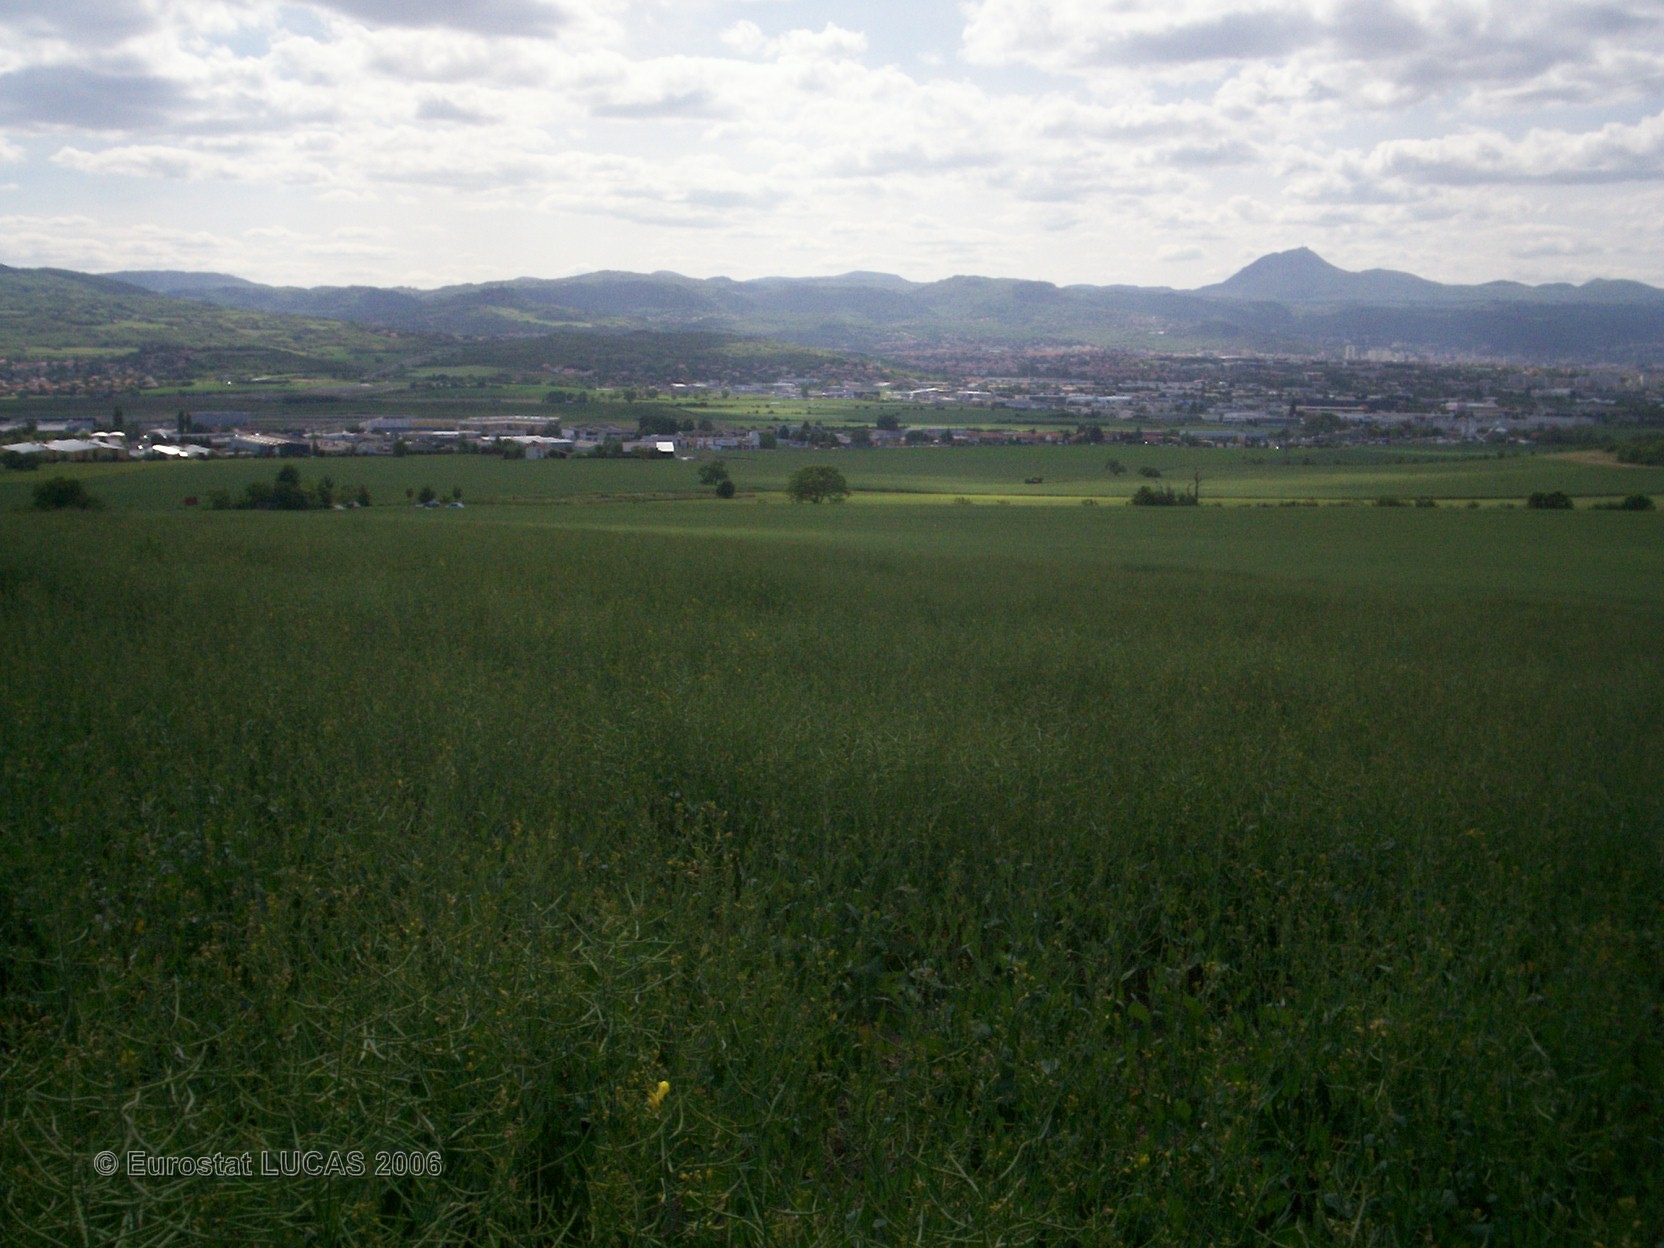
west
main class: Cropland
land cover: Rape and turnip rape
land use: Agriculture (excluding fallow land and kitchen gardens)
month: May
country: FR
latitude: 45.7535
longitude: 3.1738
